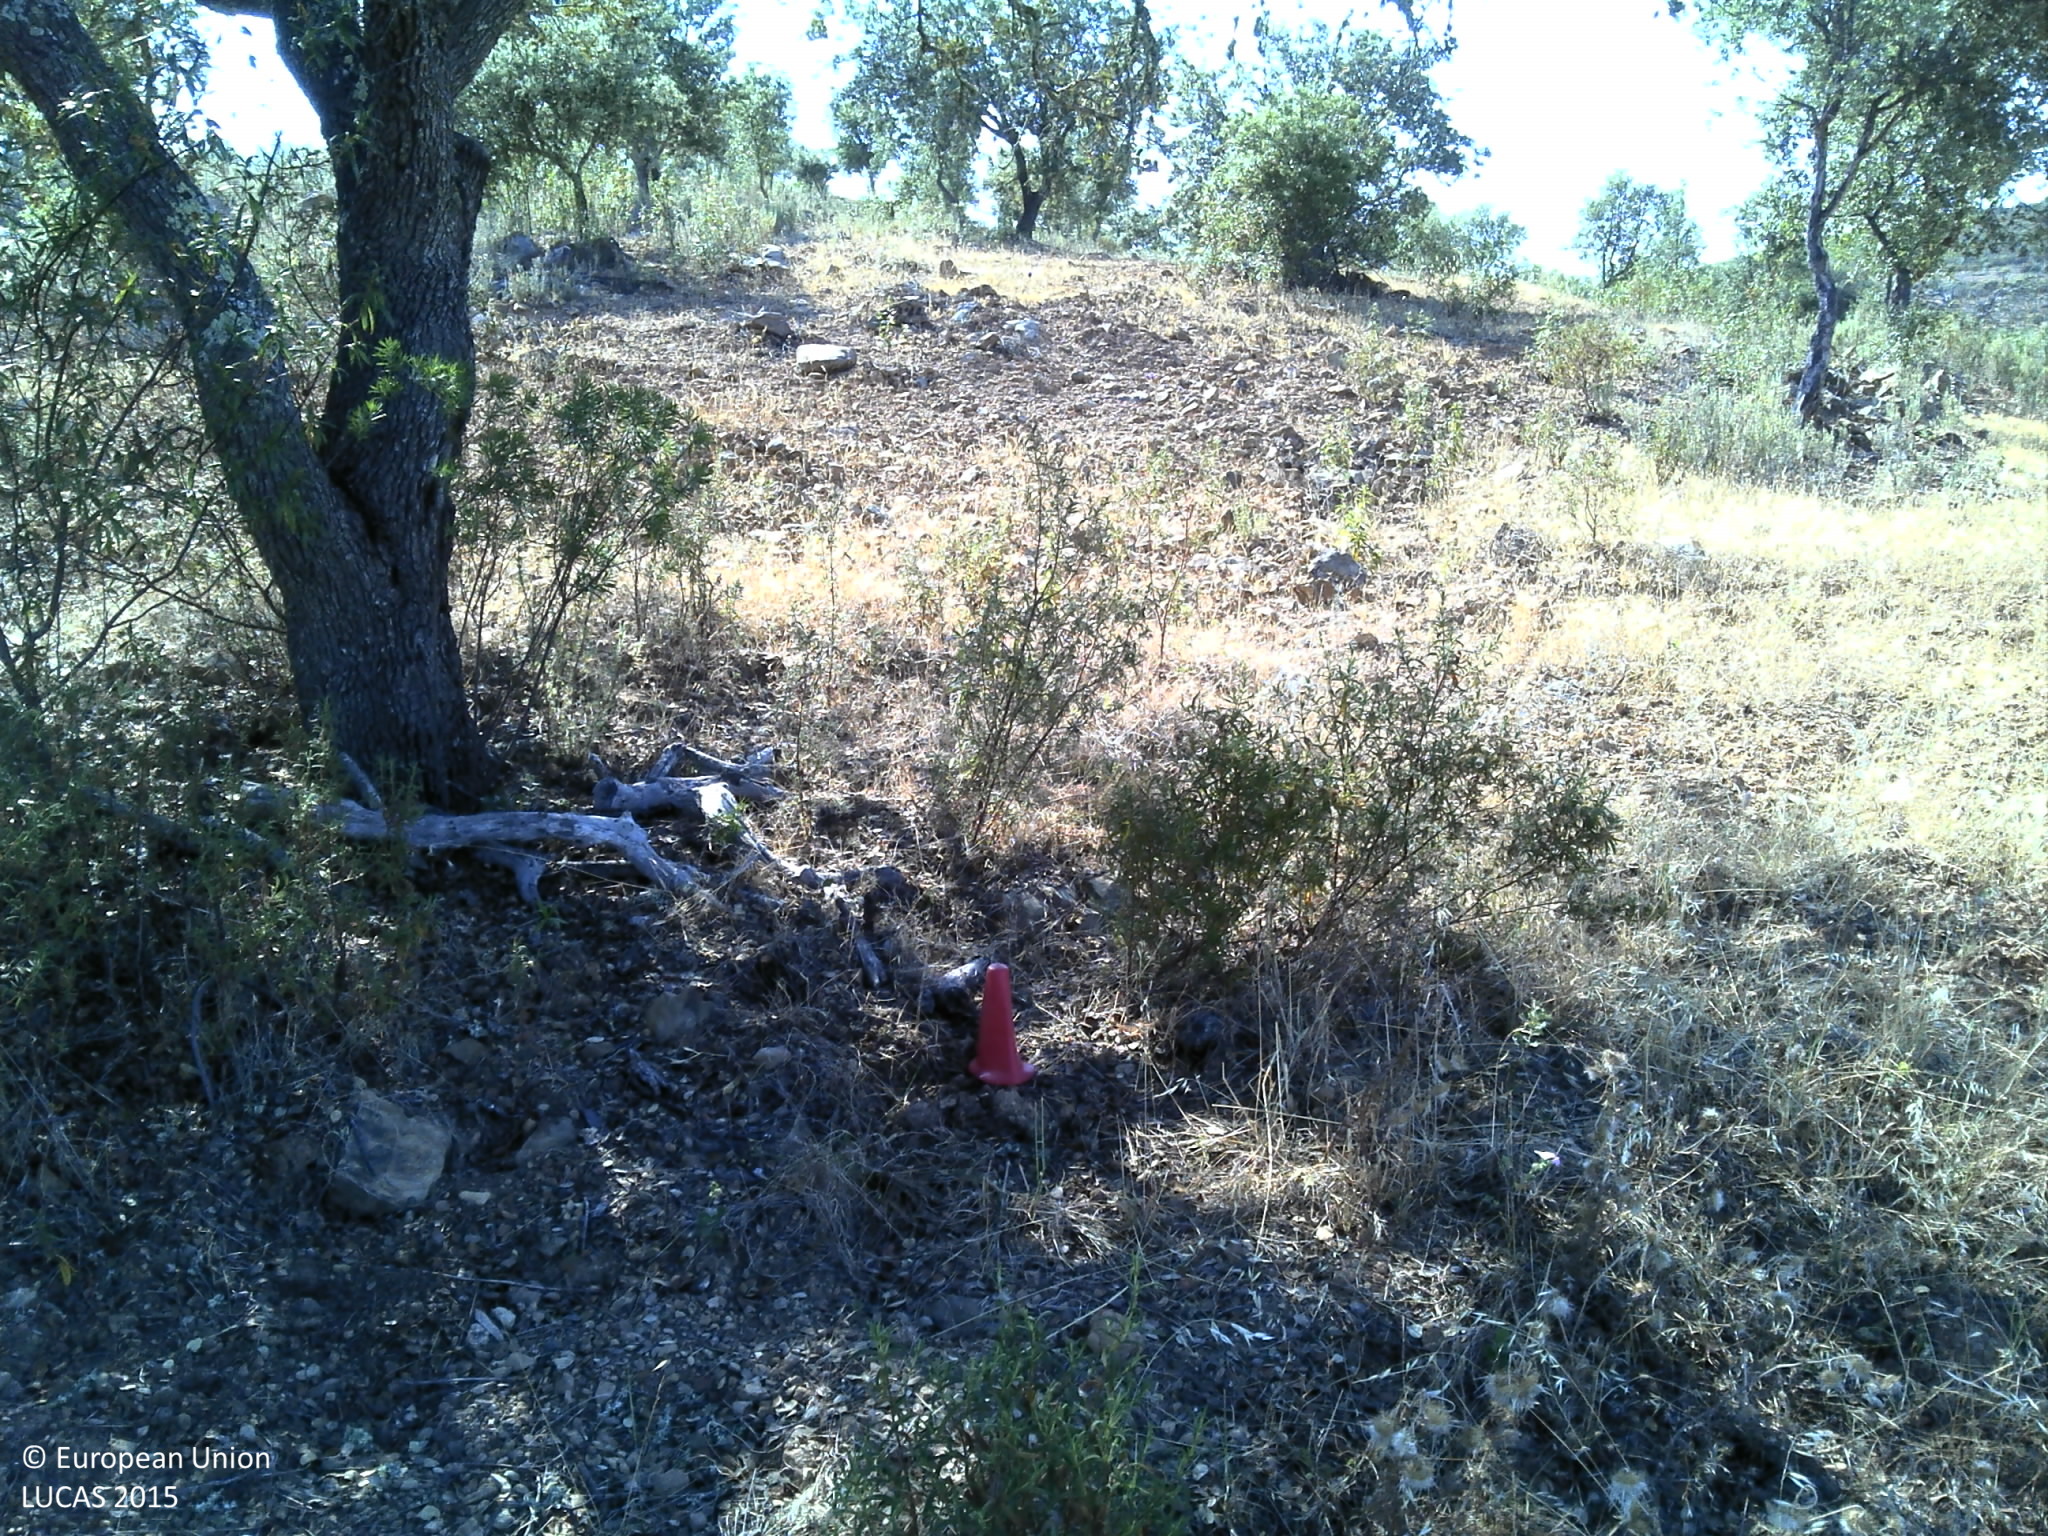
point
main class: Woodland
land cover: Broadleaved woodland
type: broadleaved evergreen forest
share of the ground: 25 - 50 %
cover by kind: broadleaved forest trees 35 %, herbaceous plants 30 %, unconsolidated bare surface 30 %, shrubs 5 %
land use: Forestry
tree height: > 5 m
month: June
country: PT
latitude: 37.4695
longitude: -7.8473
